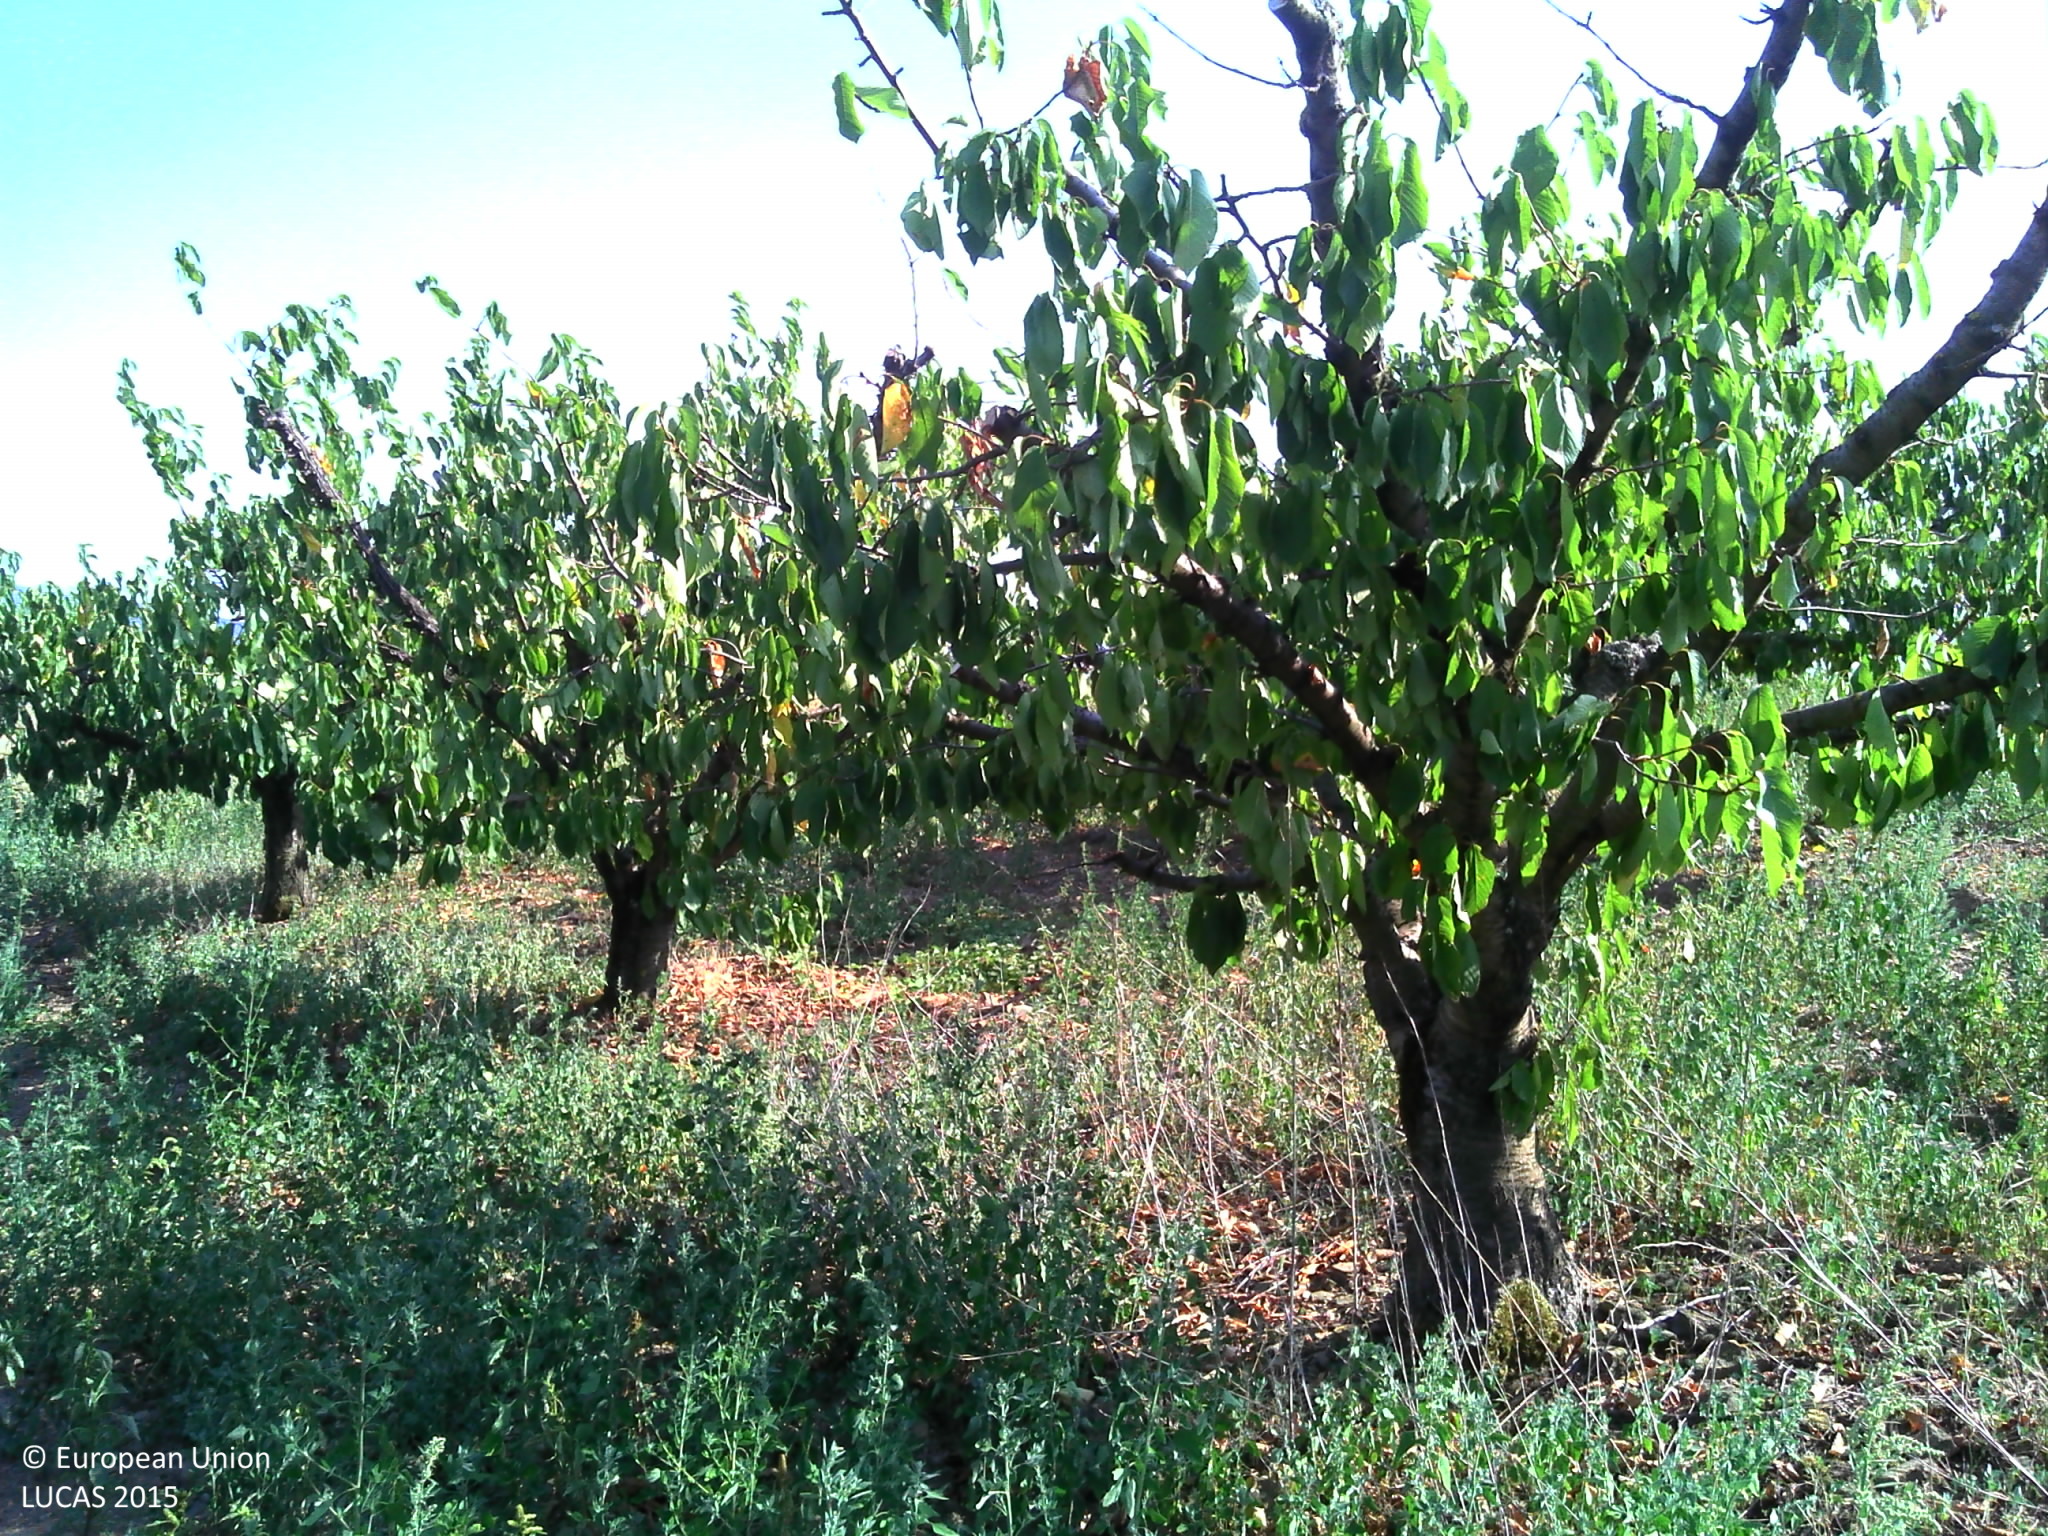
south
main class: Cropland
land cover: Cherry fruit
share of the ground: 25 - 50 %
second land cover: Spontaneously vegetated surfaces
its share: > 75 %
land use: Agriculture (excluding fallow land and kitchen gardens)
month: August
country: FR
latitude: 45.5268
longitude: 4.5622
